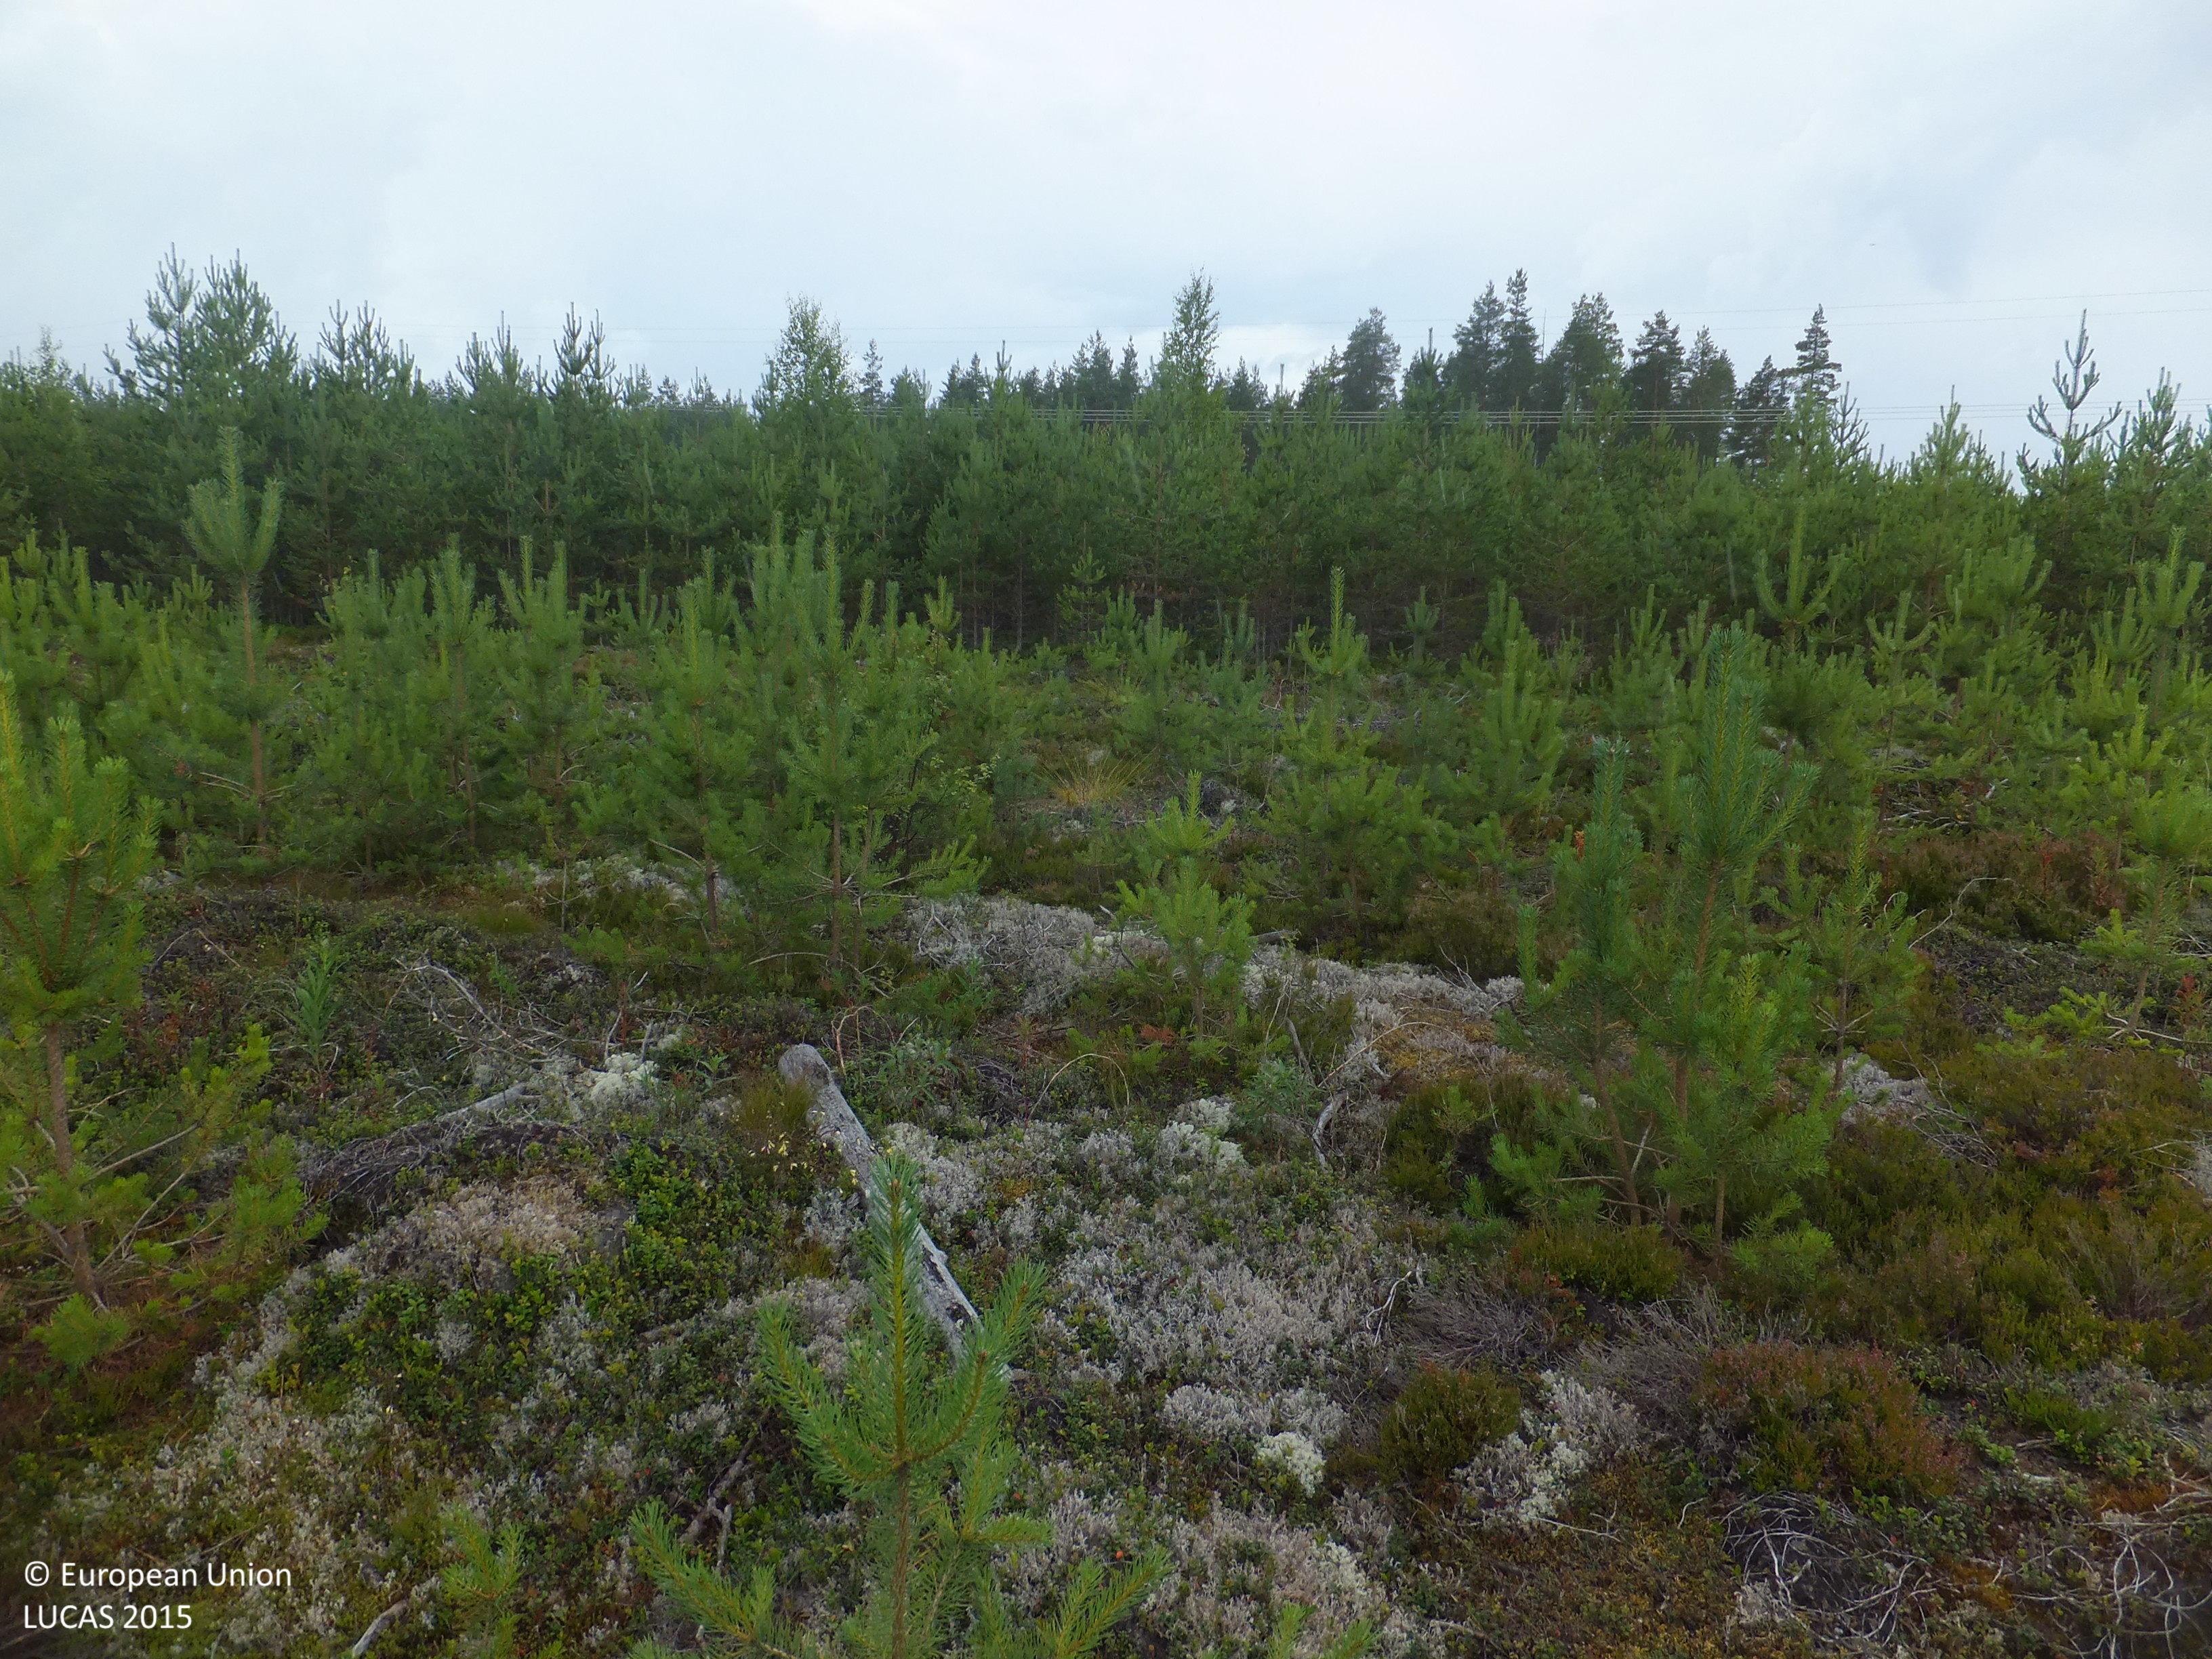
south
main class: Woodland
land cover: Pine dominated coniferous woodland
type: boreal forest
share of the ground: 25 - 50 %
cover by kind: coniferous forest trees 25 %, shrubs 20 %, lichens and mosses 20 %, unconsolidated bare surface 20 %, herbaceous plants 10 %, broadleaved forest trees 5 %
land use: Forestry
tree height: < 5 m
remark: Nursery
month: July
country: FI
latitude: 63.6040
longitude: 23.4266
